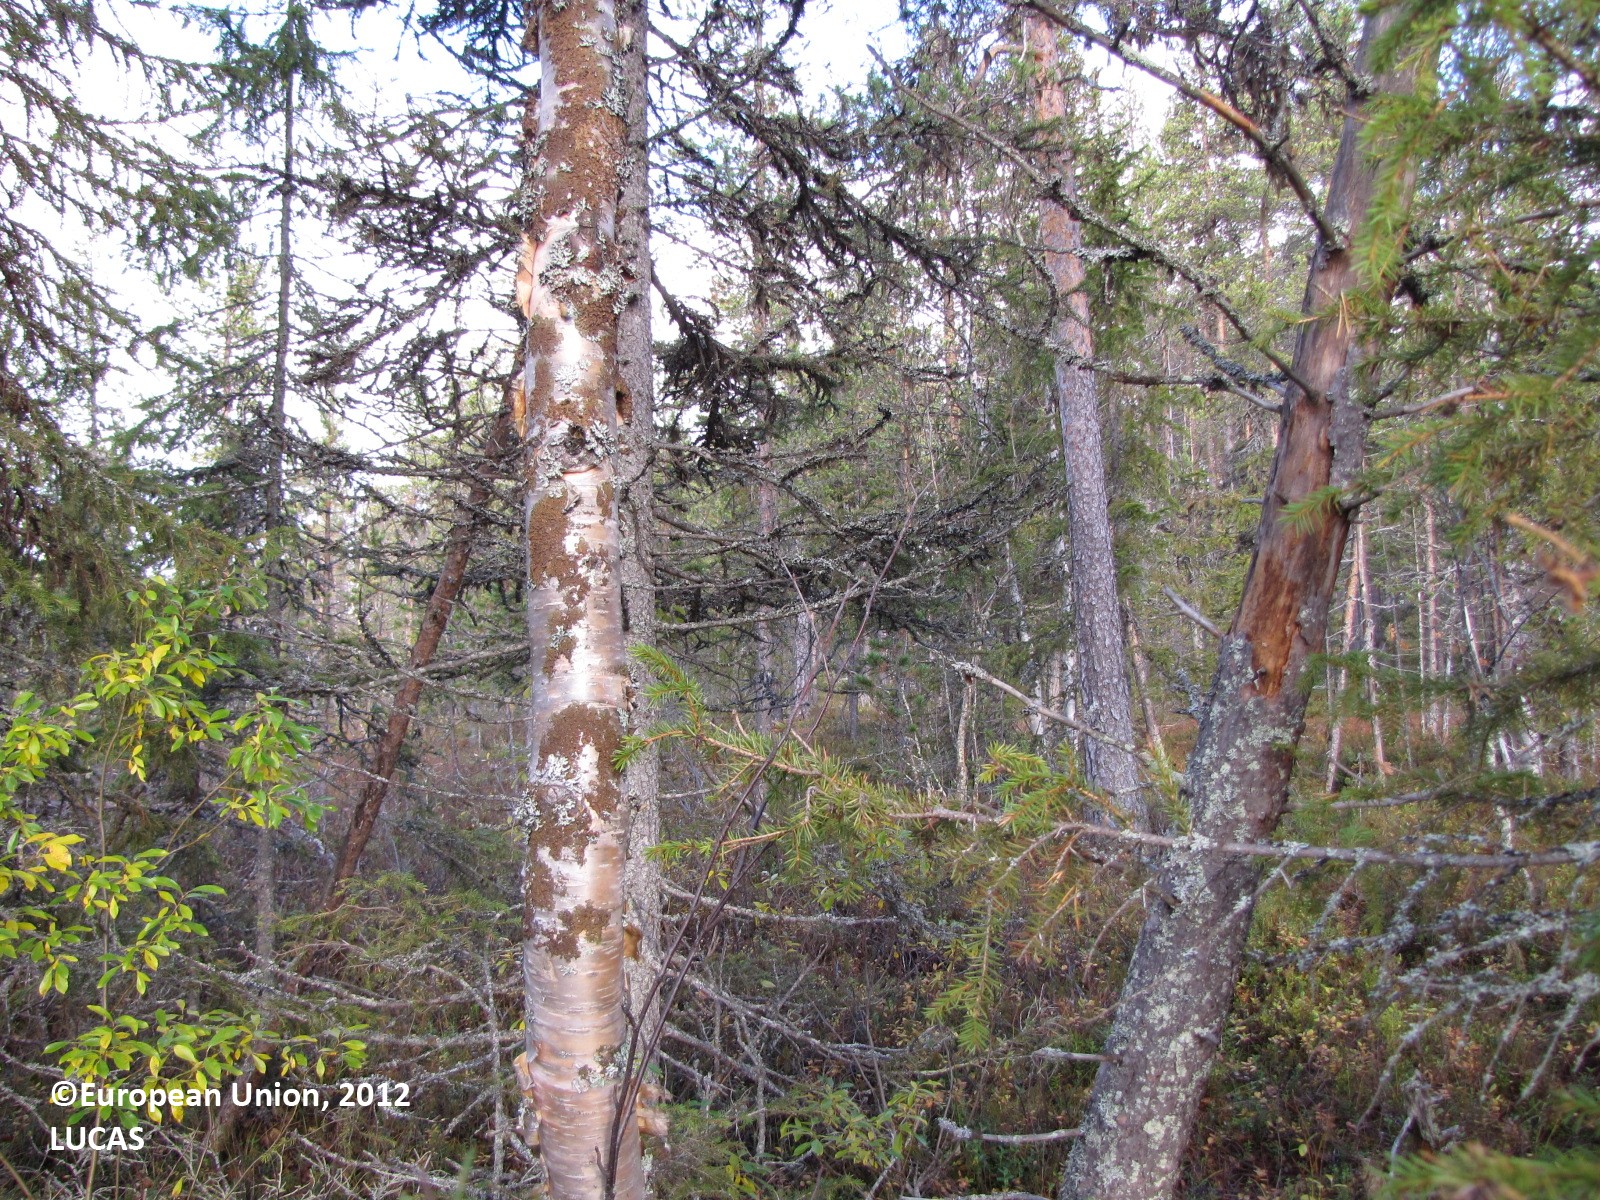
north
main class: Woodland
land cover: Pine dominated coniferous woodland
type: boreal forest
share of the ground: 25 - 50 %
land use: Forestry
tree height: > 5 m
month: September
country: FI
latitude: 67.8421
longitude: 23.6269
